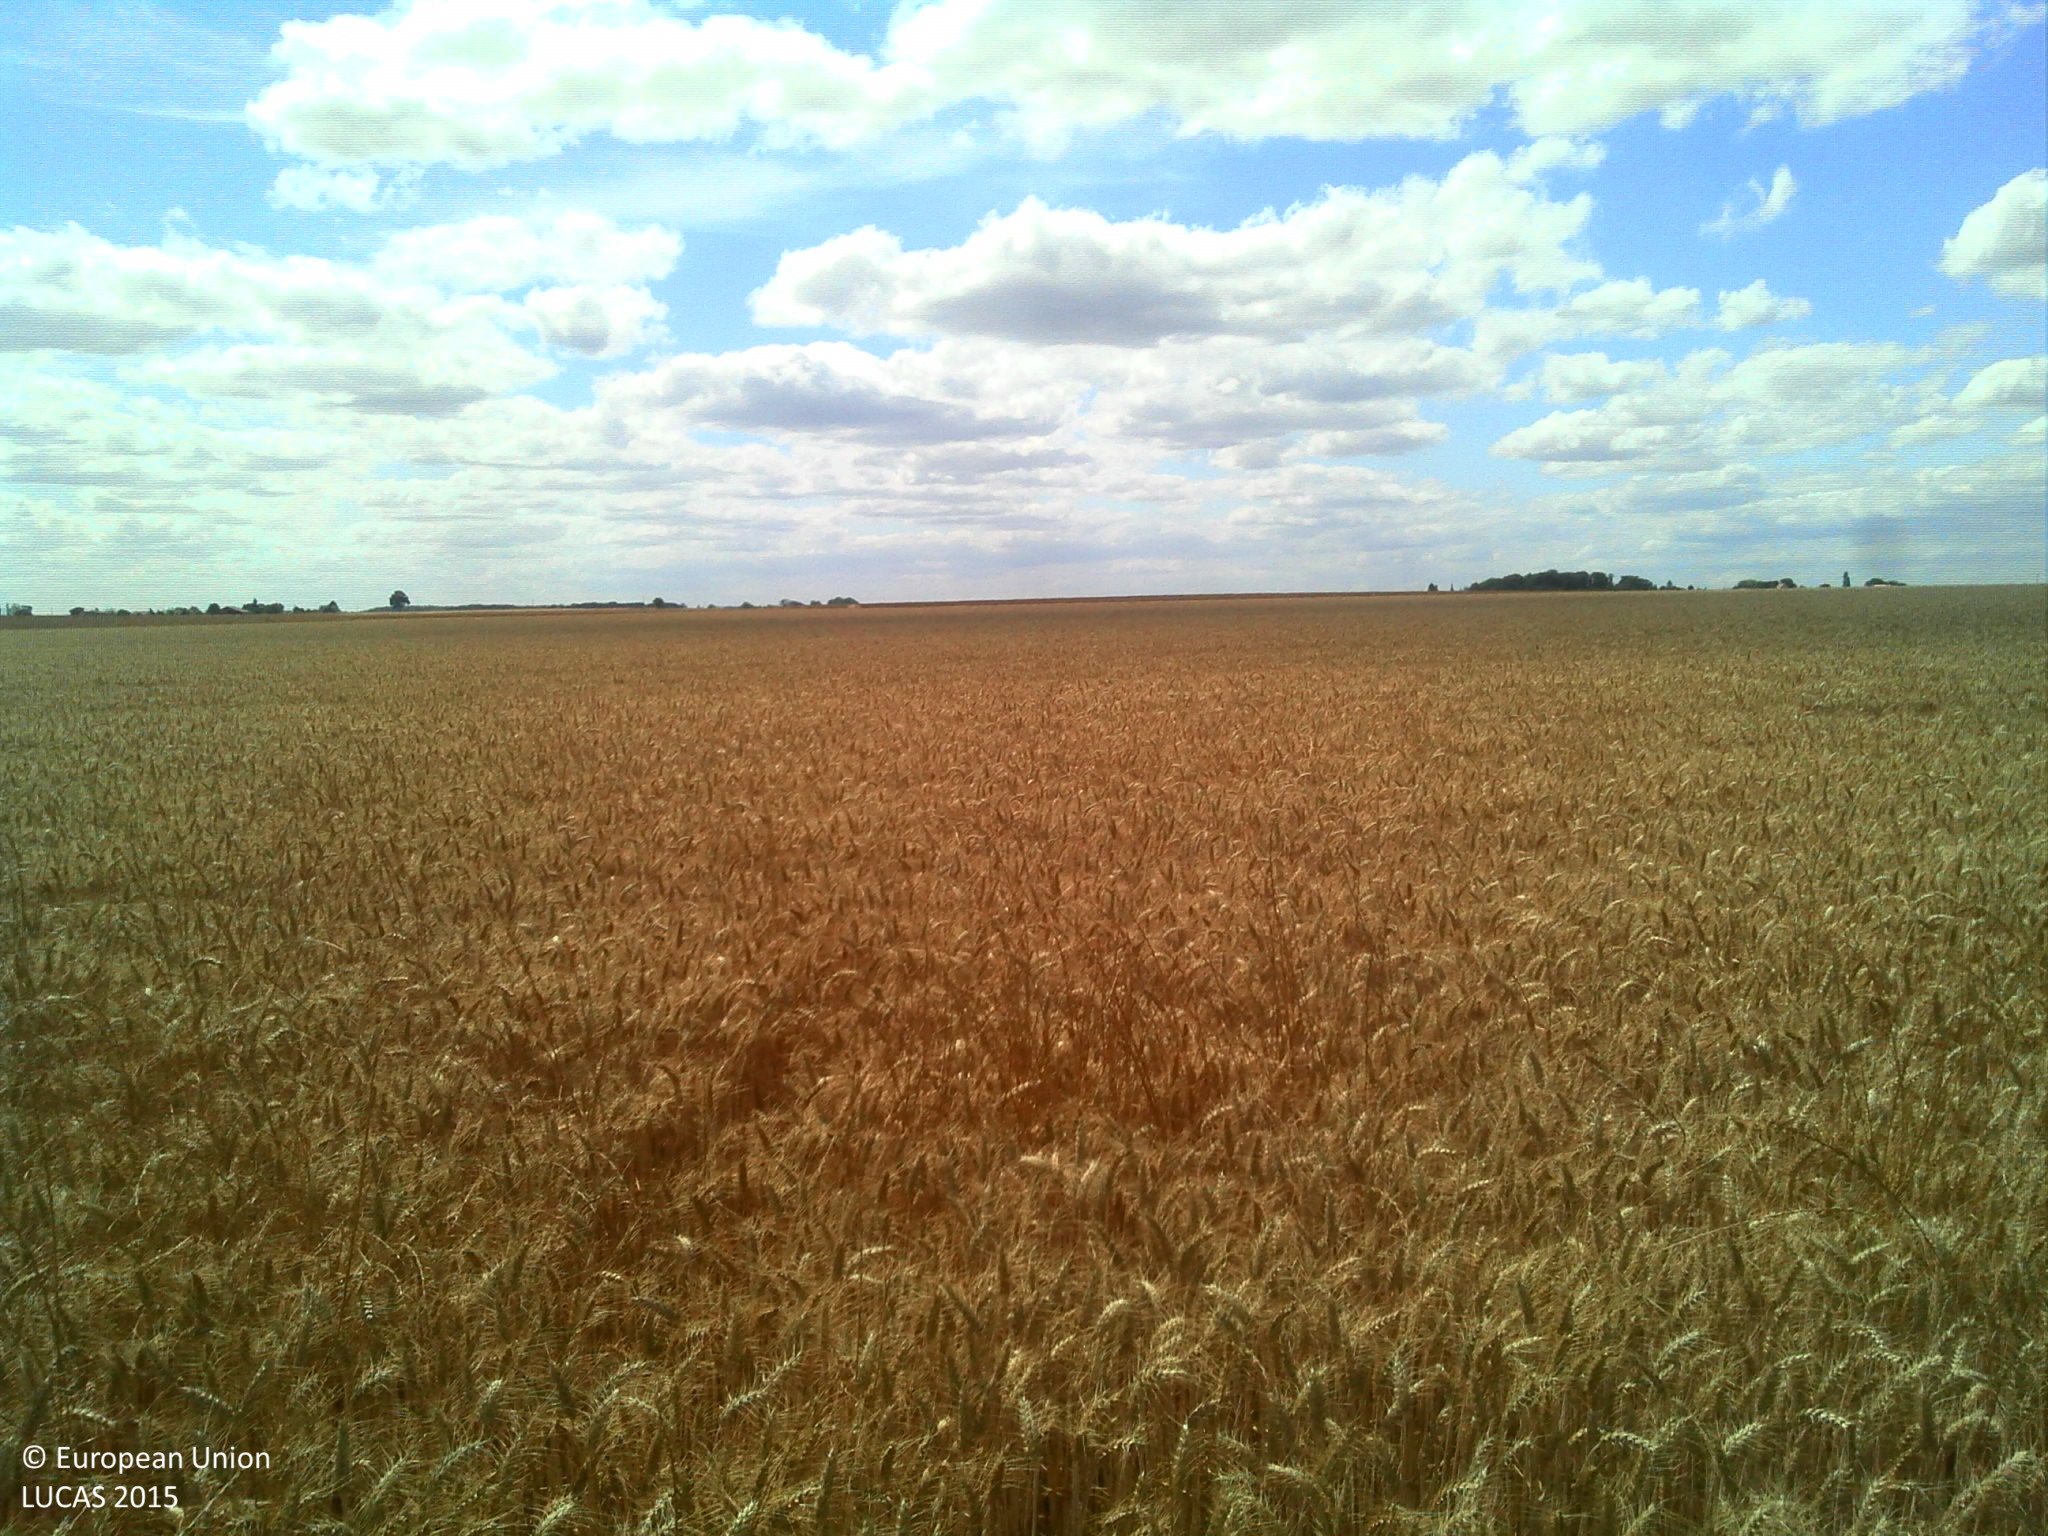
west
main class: Cropland
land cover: Rape and turnip rape
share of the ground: > 75 %
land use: Agriculture (excluding fallow land and kitchen gardens)
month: July
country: FR
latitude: 48.4015
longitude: 1.2694
